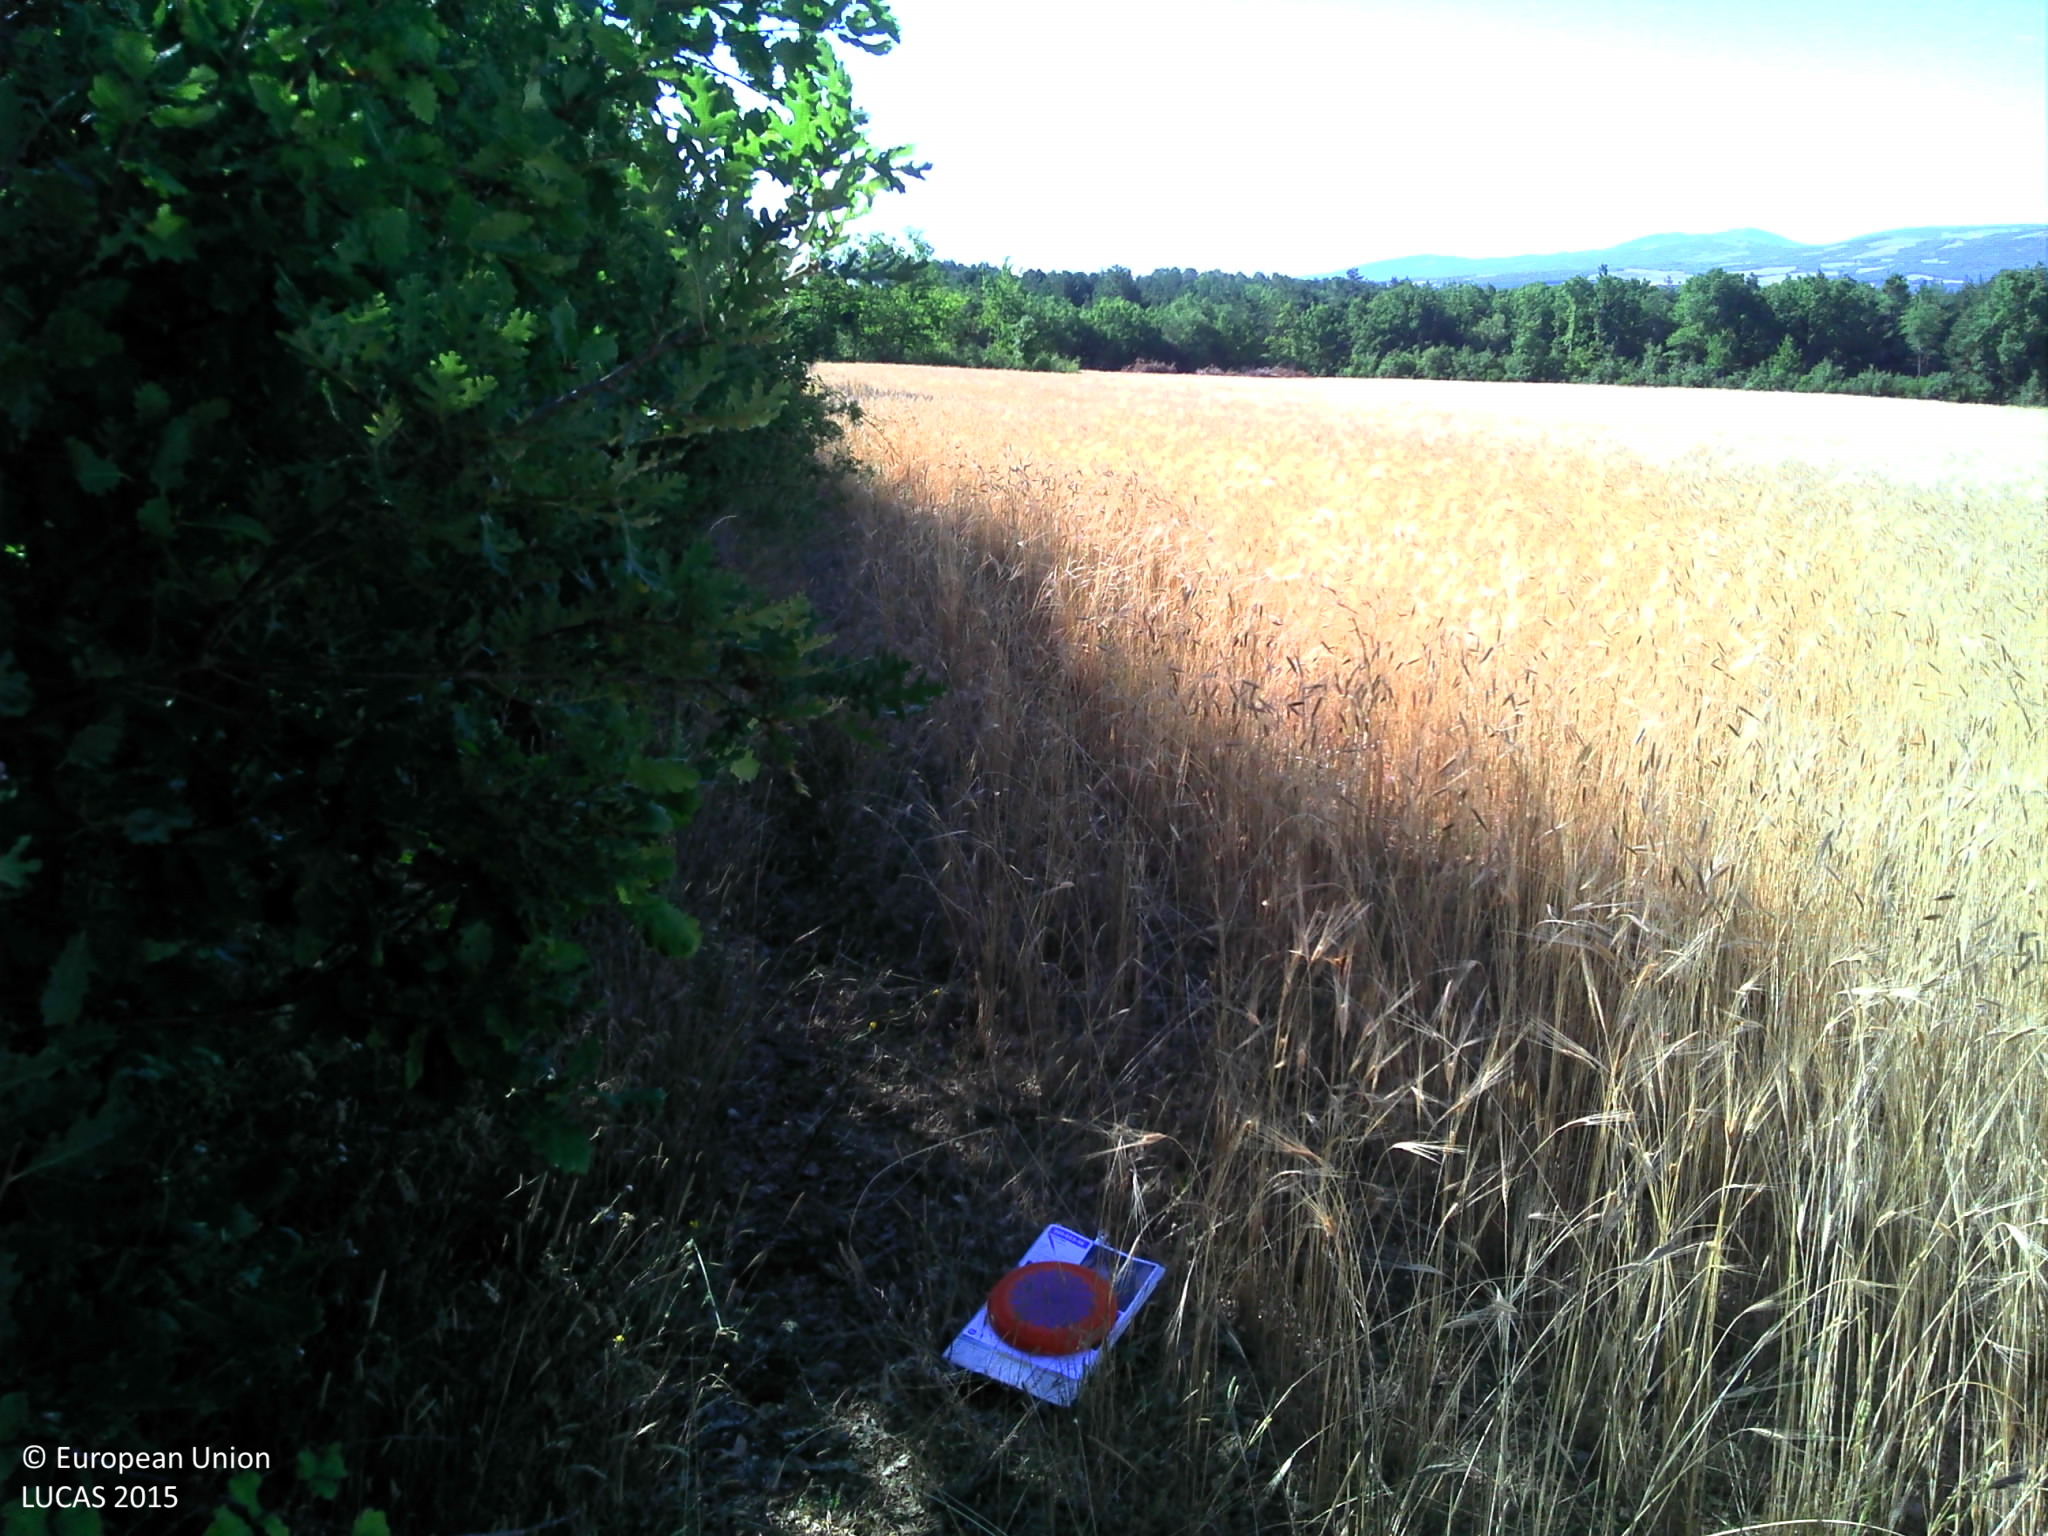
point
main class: Cropland
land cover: Barley
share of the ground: > 75 %
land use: Agriculture (excluding fallow land and kitchen gardens)
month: July
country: FR
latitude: 44.1242
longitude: 5.4466
